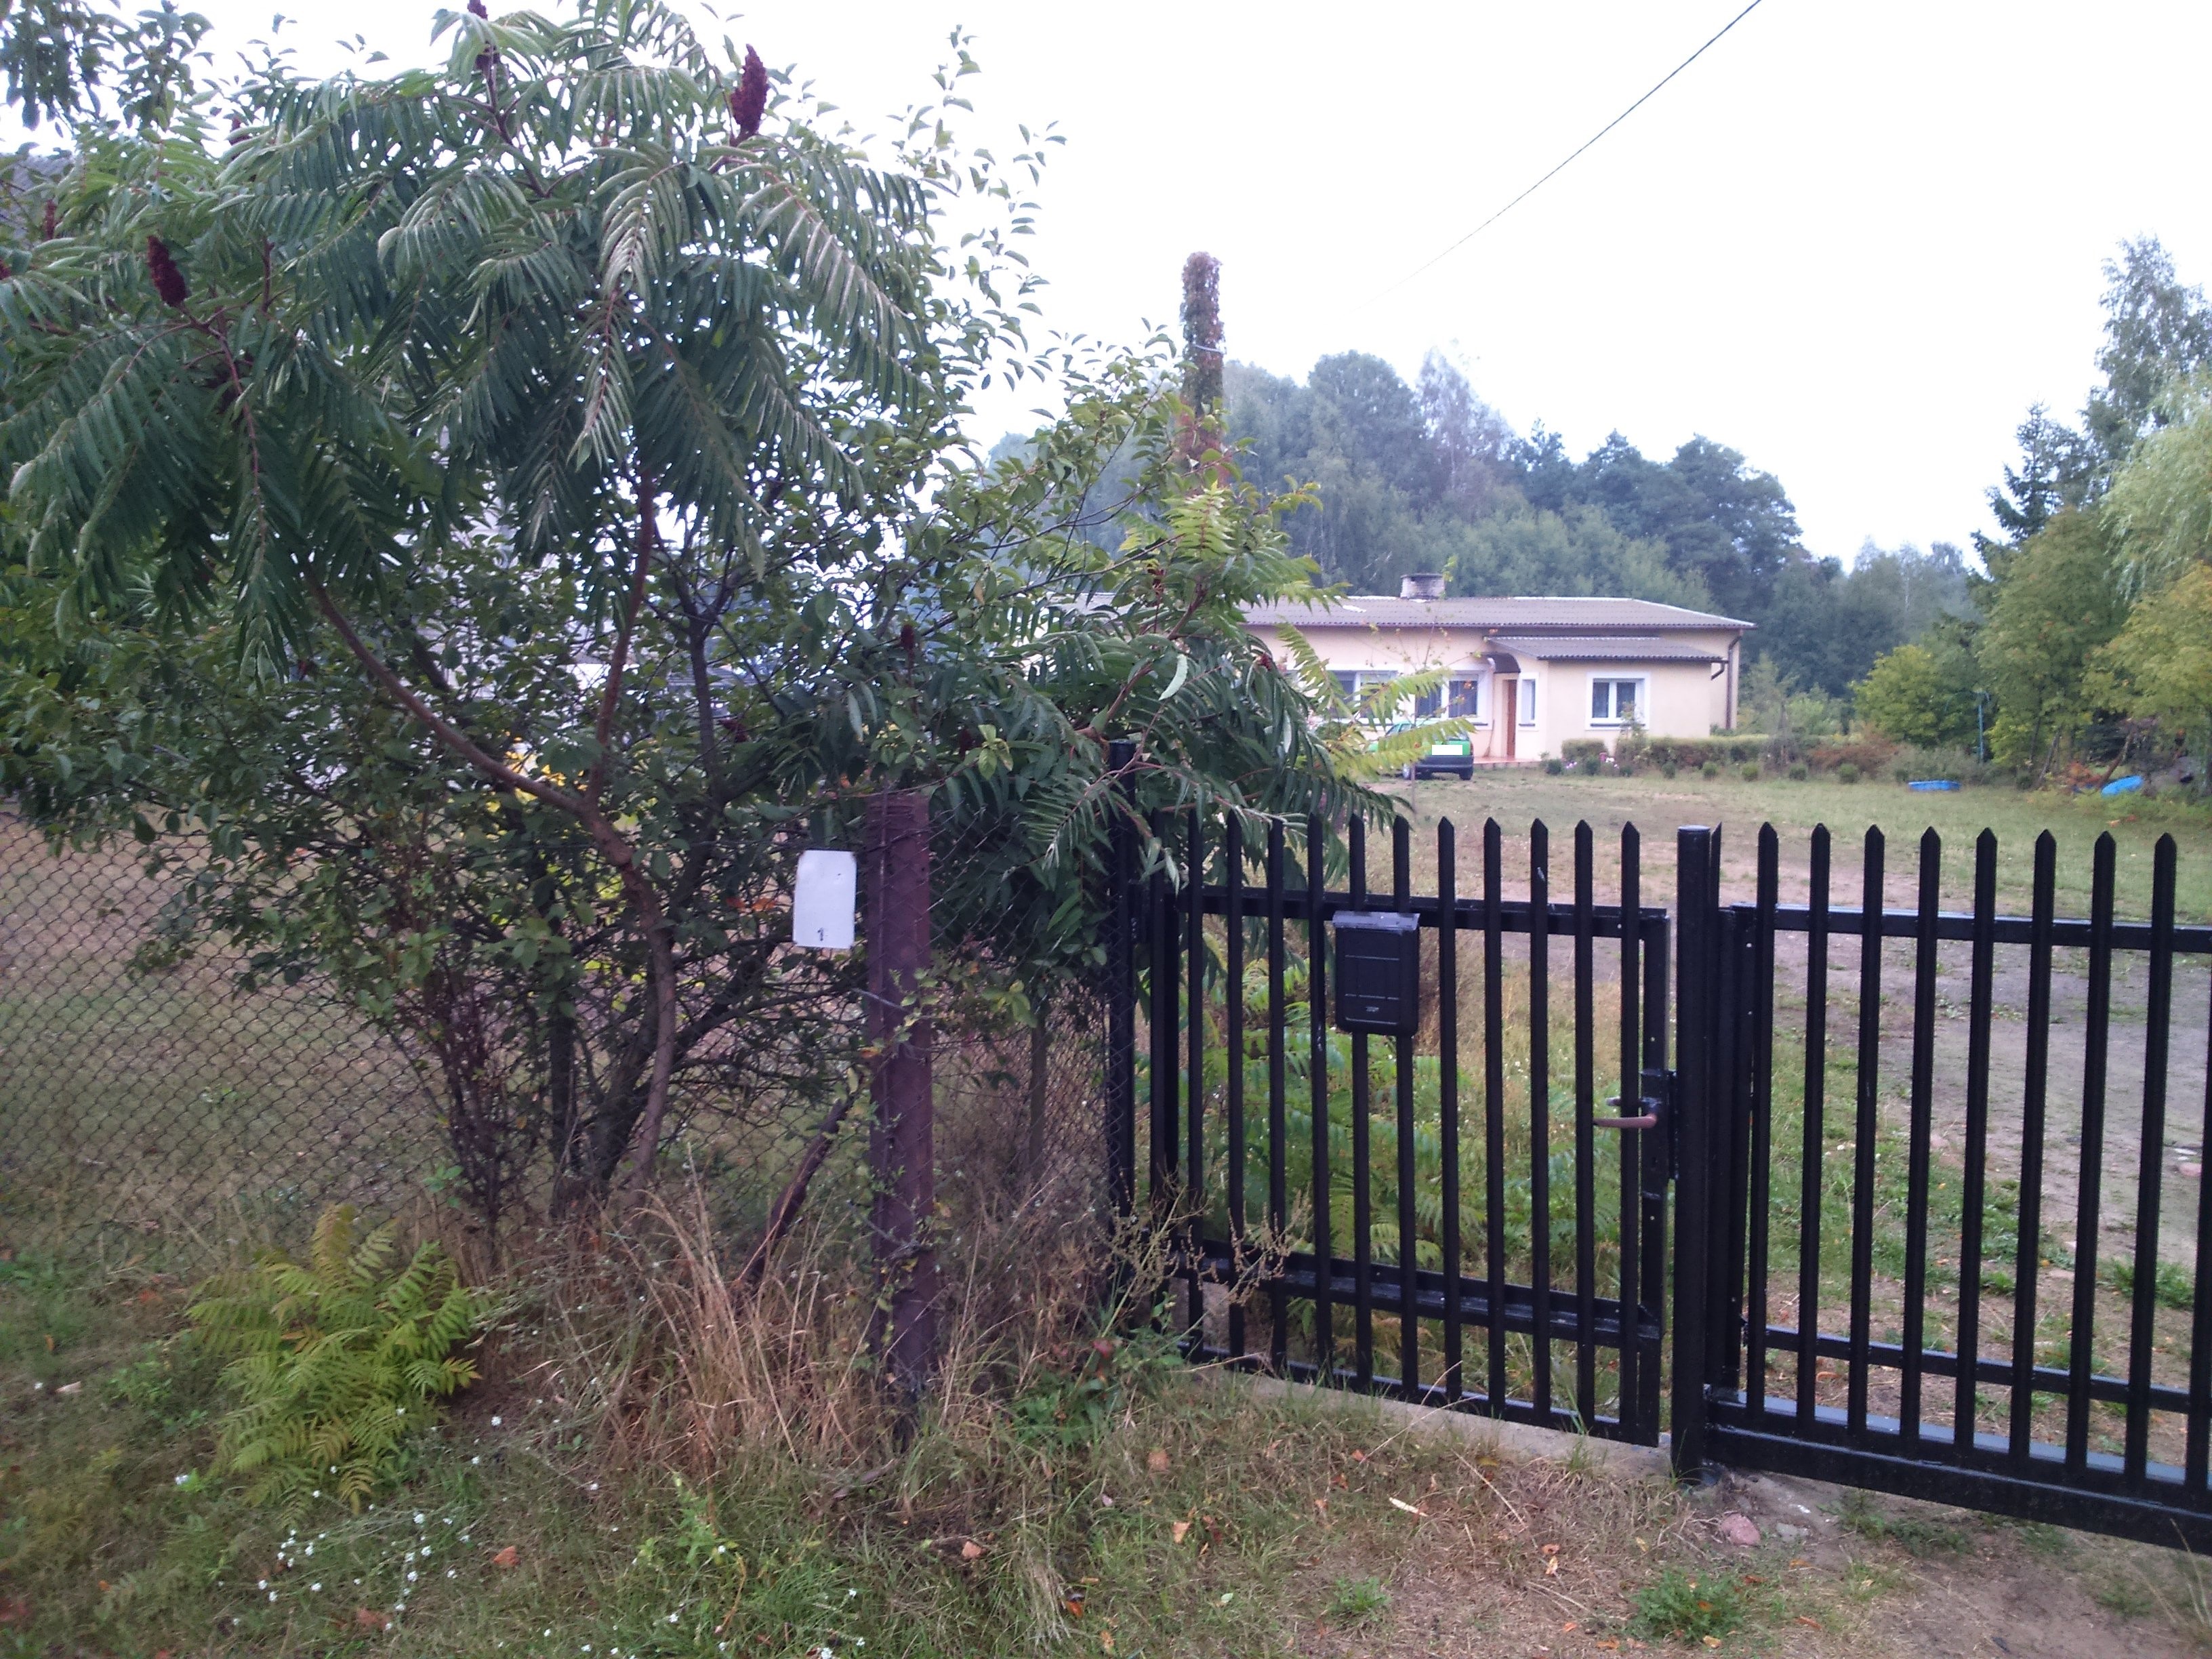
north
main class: Grassland
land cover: Grassland with sparse tree/shrub cover
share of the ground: > 75 %
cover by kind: herbaceous plants 90 %, broadleaved forest trees 5 %, shrubs 5 %
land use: Road transport
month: September
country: PL
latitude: 52.3809
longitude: 22.2111
